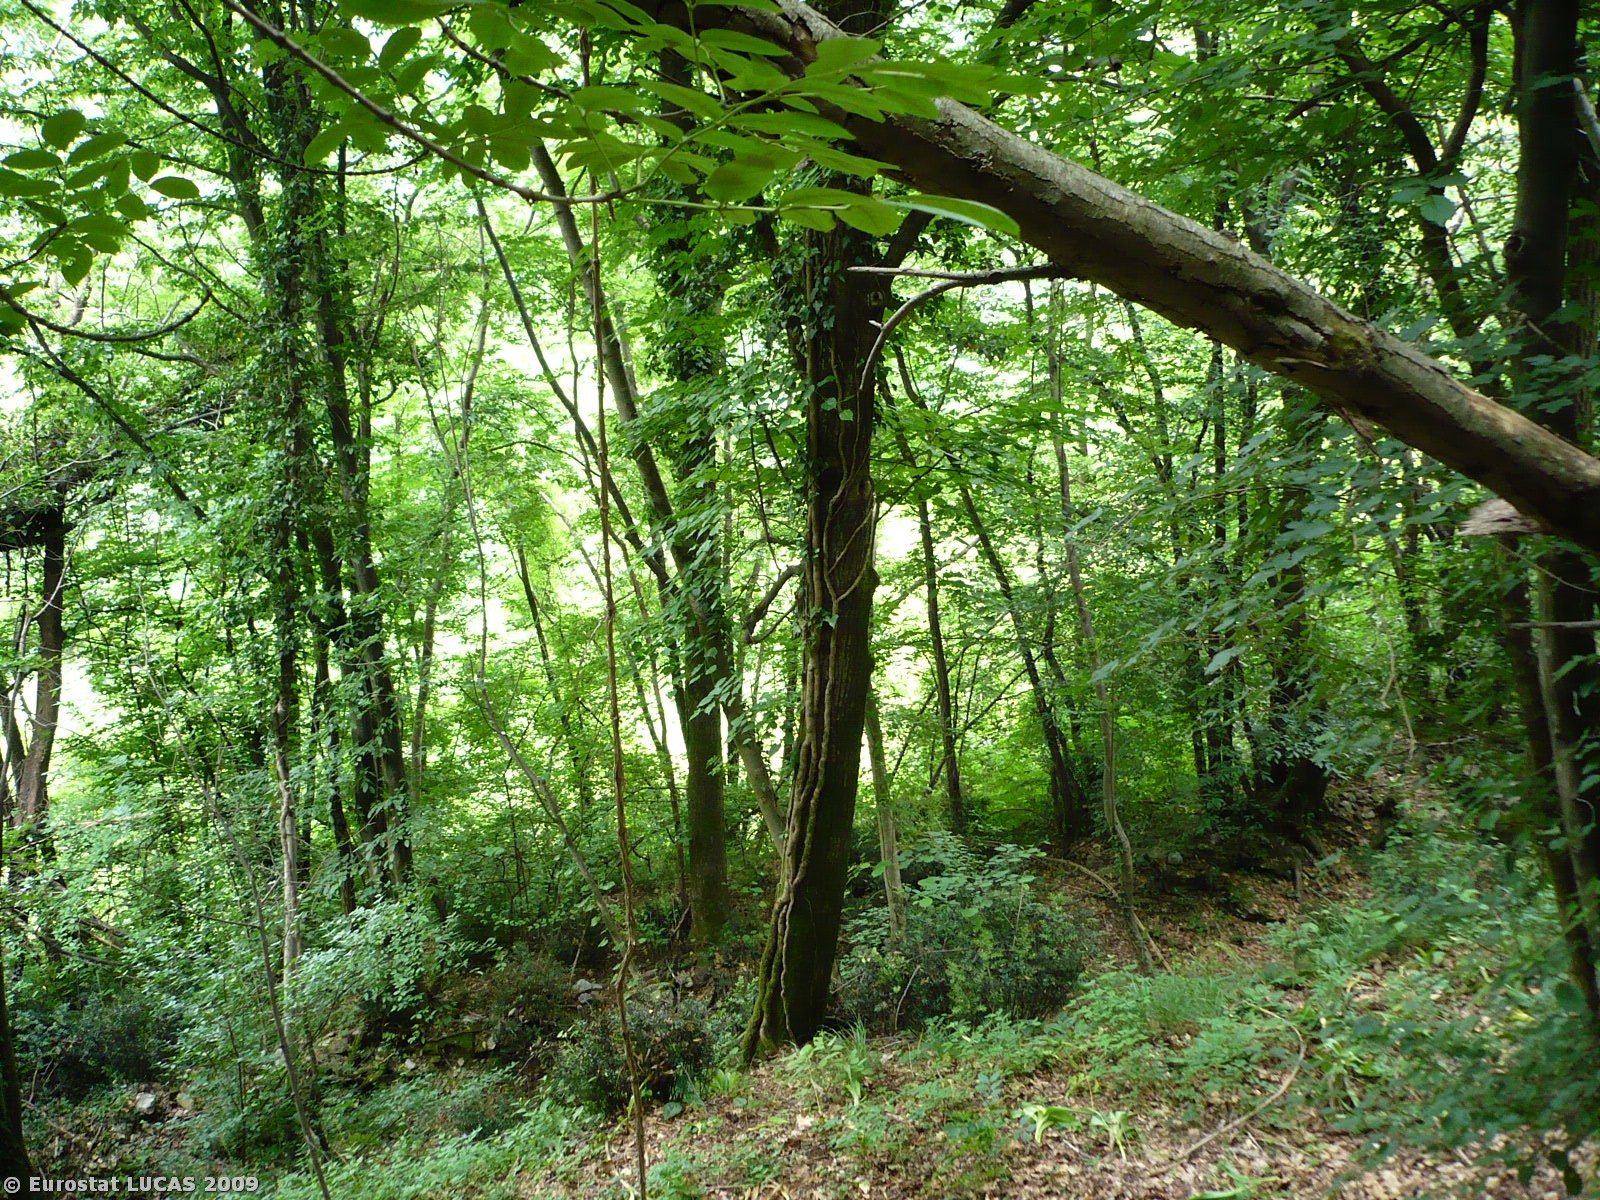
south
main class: Woodland
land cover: Broadleaved woodland
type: beech forest
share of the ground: > 75 %
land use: Unused
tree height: > 5 m
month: June
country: SI
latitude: 46.1084
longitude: 13.6578
